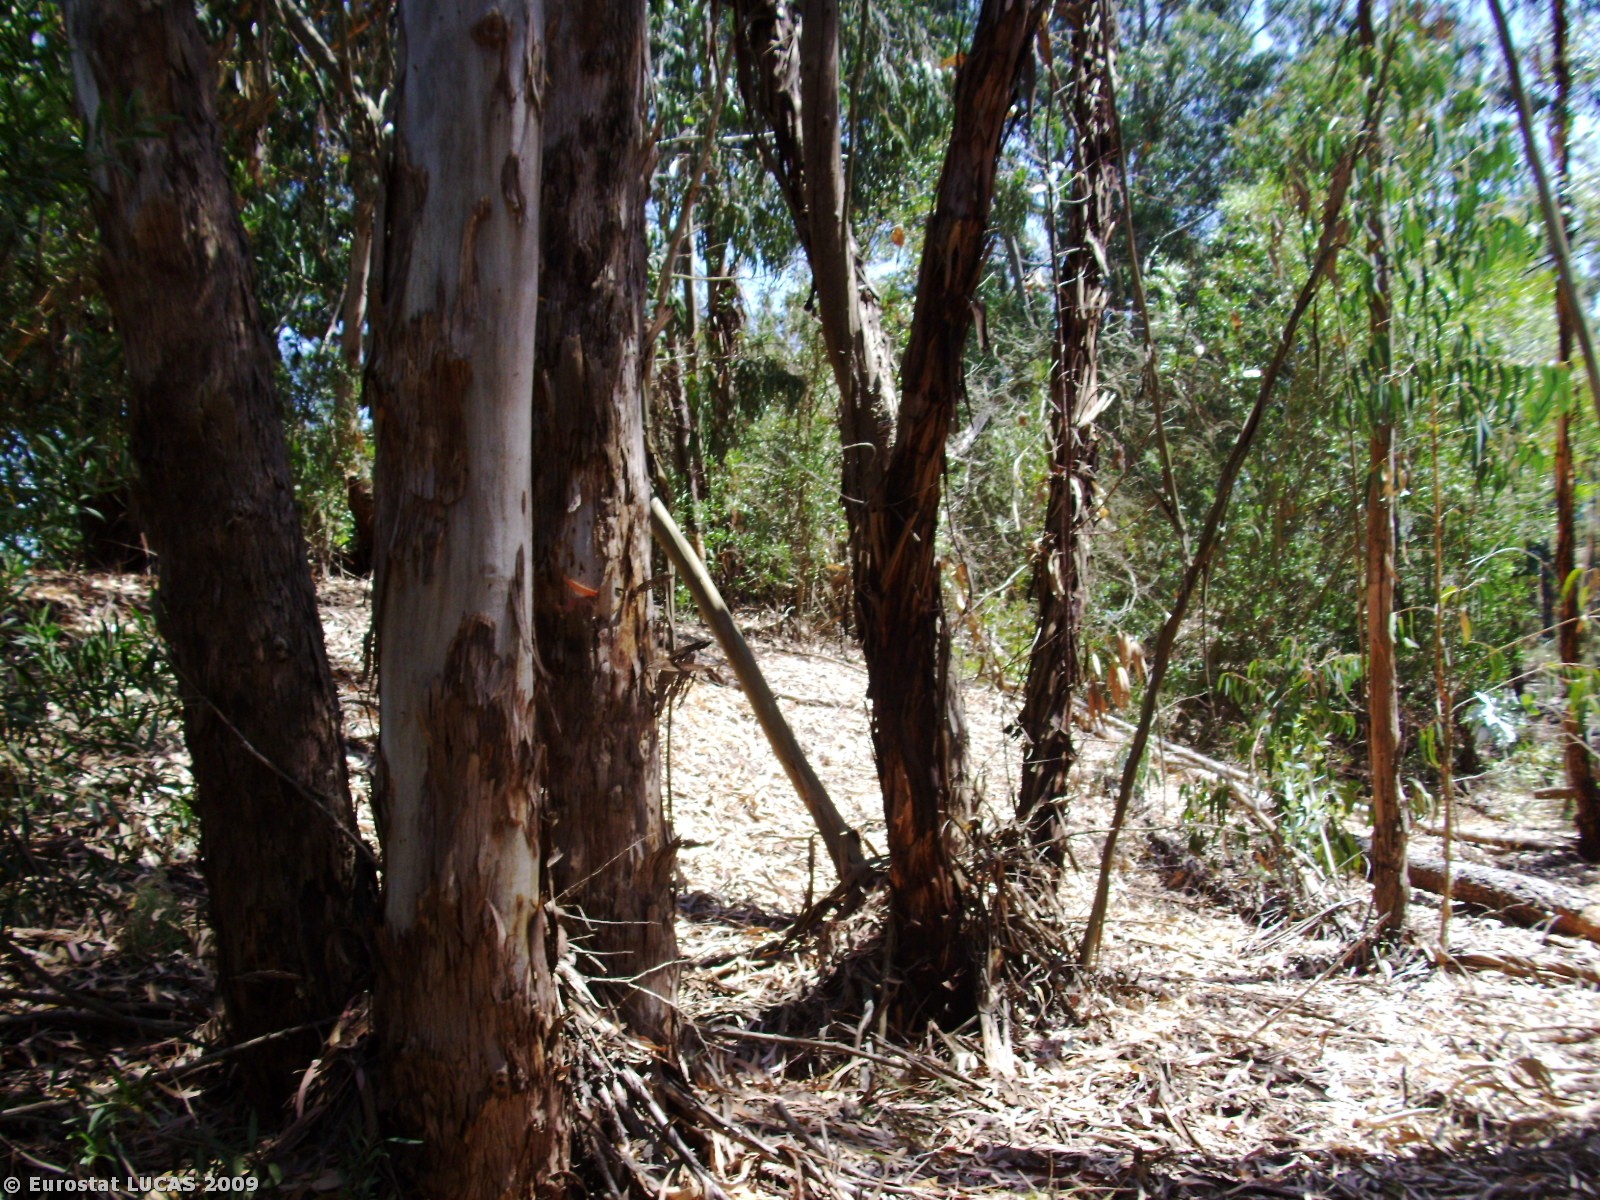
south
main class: Woodland
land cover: Broadleaved woodland
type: plantations and self-sown exotic forest
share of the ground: 50 - 75 %
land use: Forestry
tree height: > 5 m
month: June
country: PT
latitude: 38.1791
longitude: -8.7641
